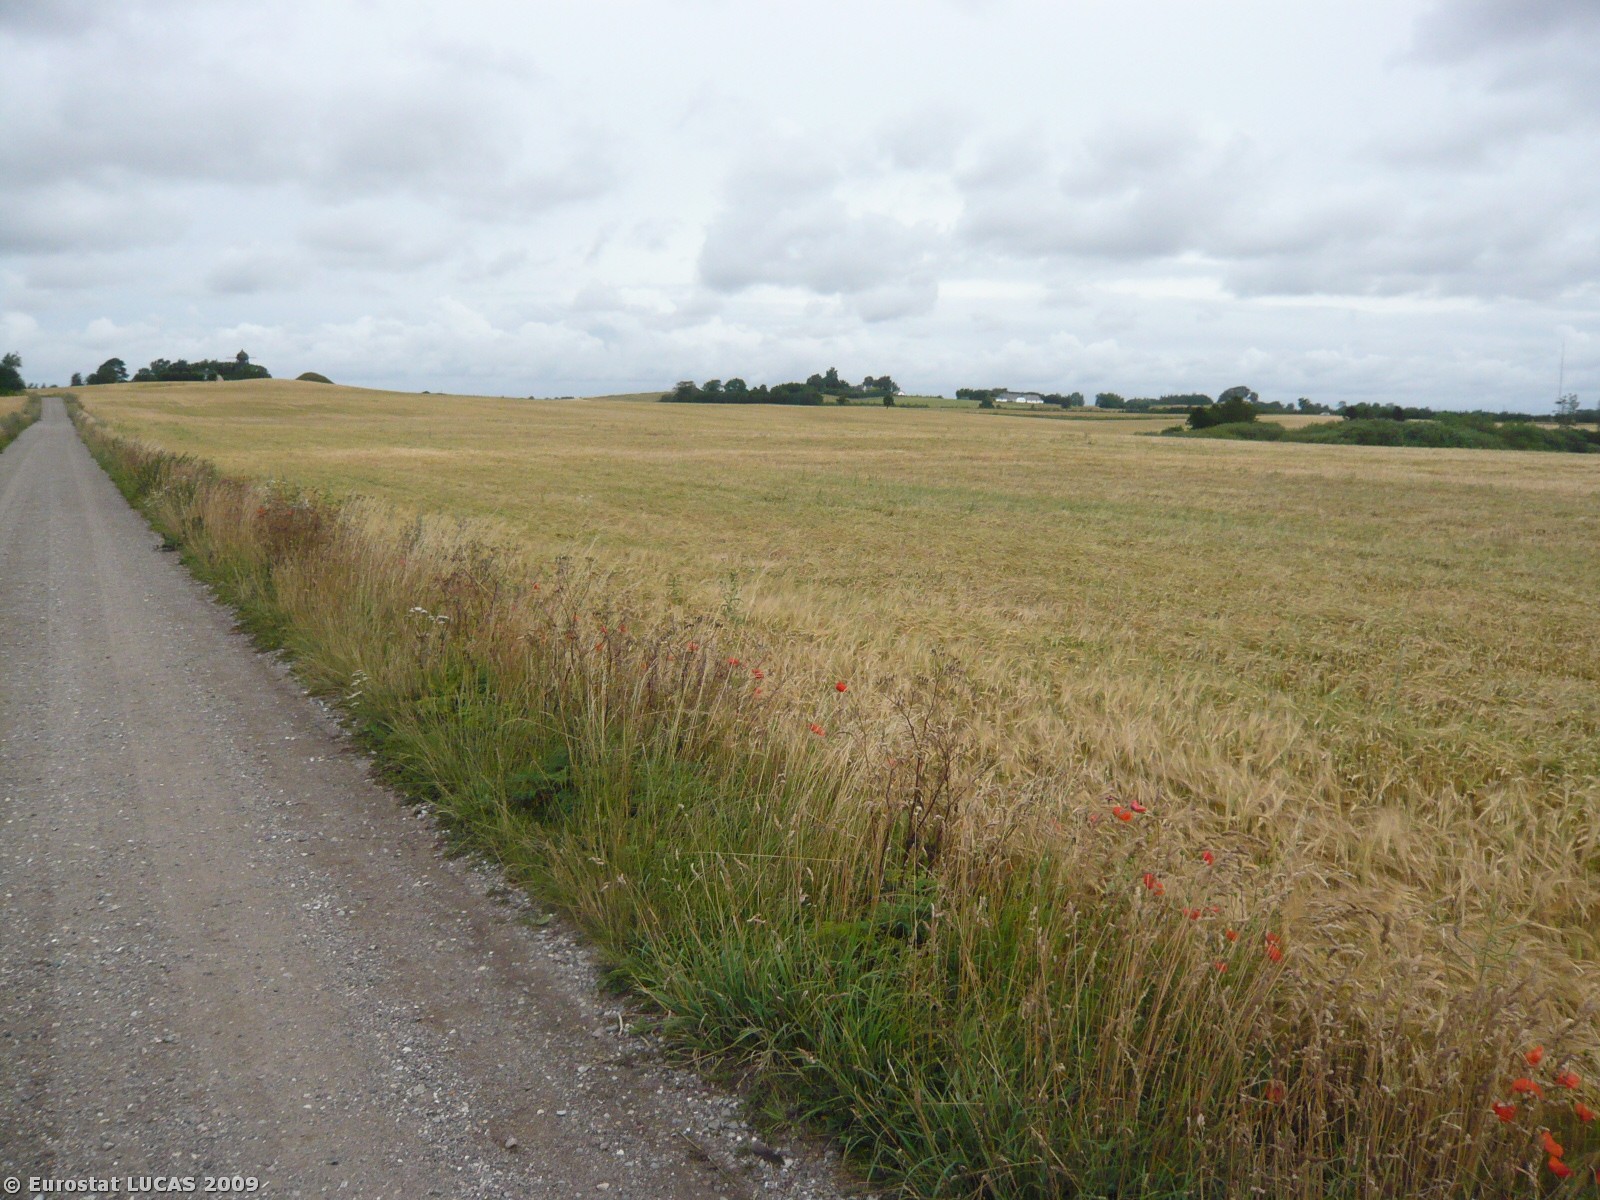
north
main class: Cropland
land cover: Barley
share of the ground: > 75 %
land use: Agriculture (excluding fallow land and kitchen gardens)
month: July
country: DK
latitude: 55.6838
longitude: 12.1771
